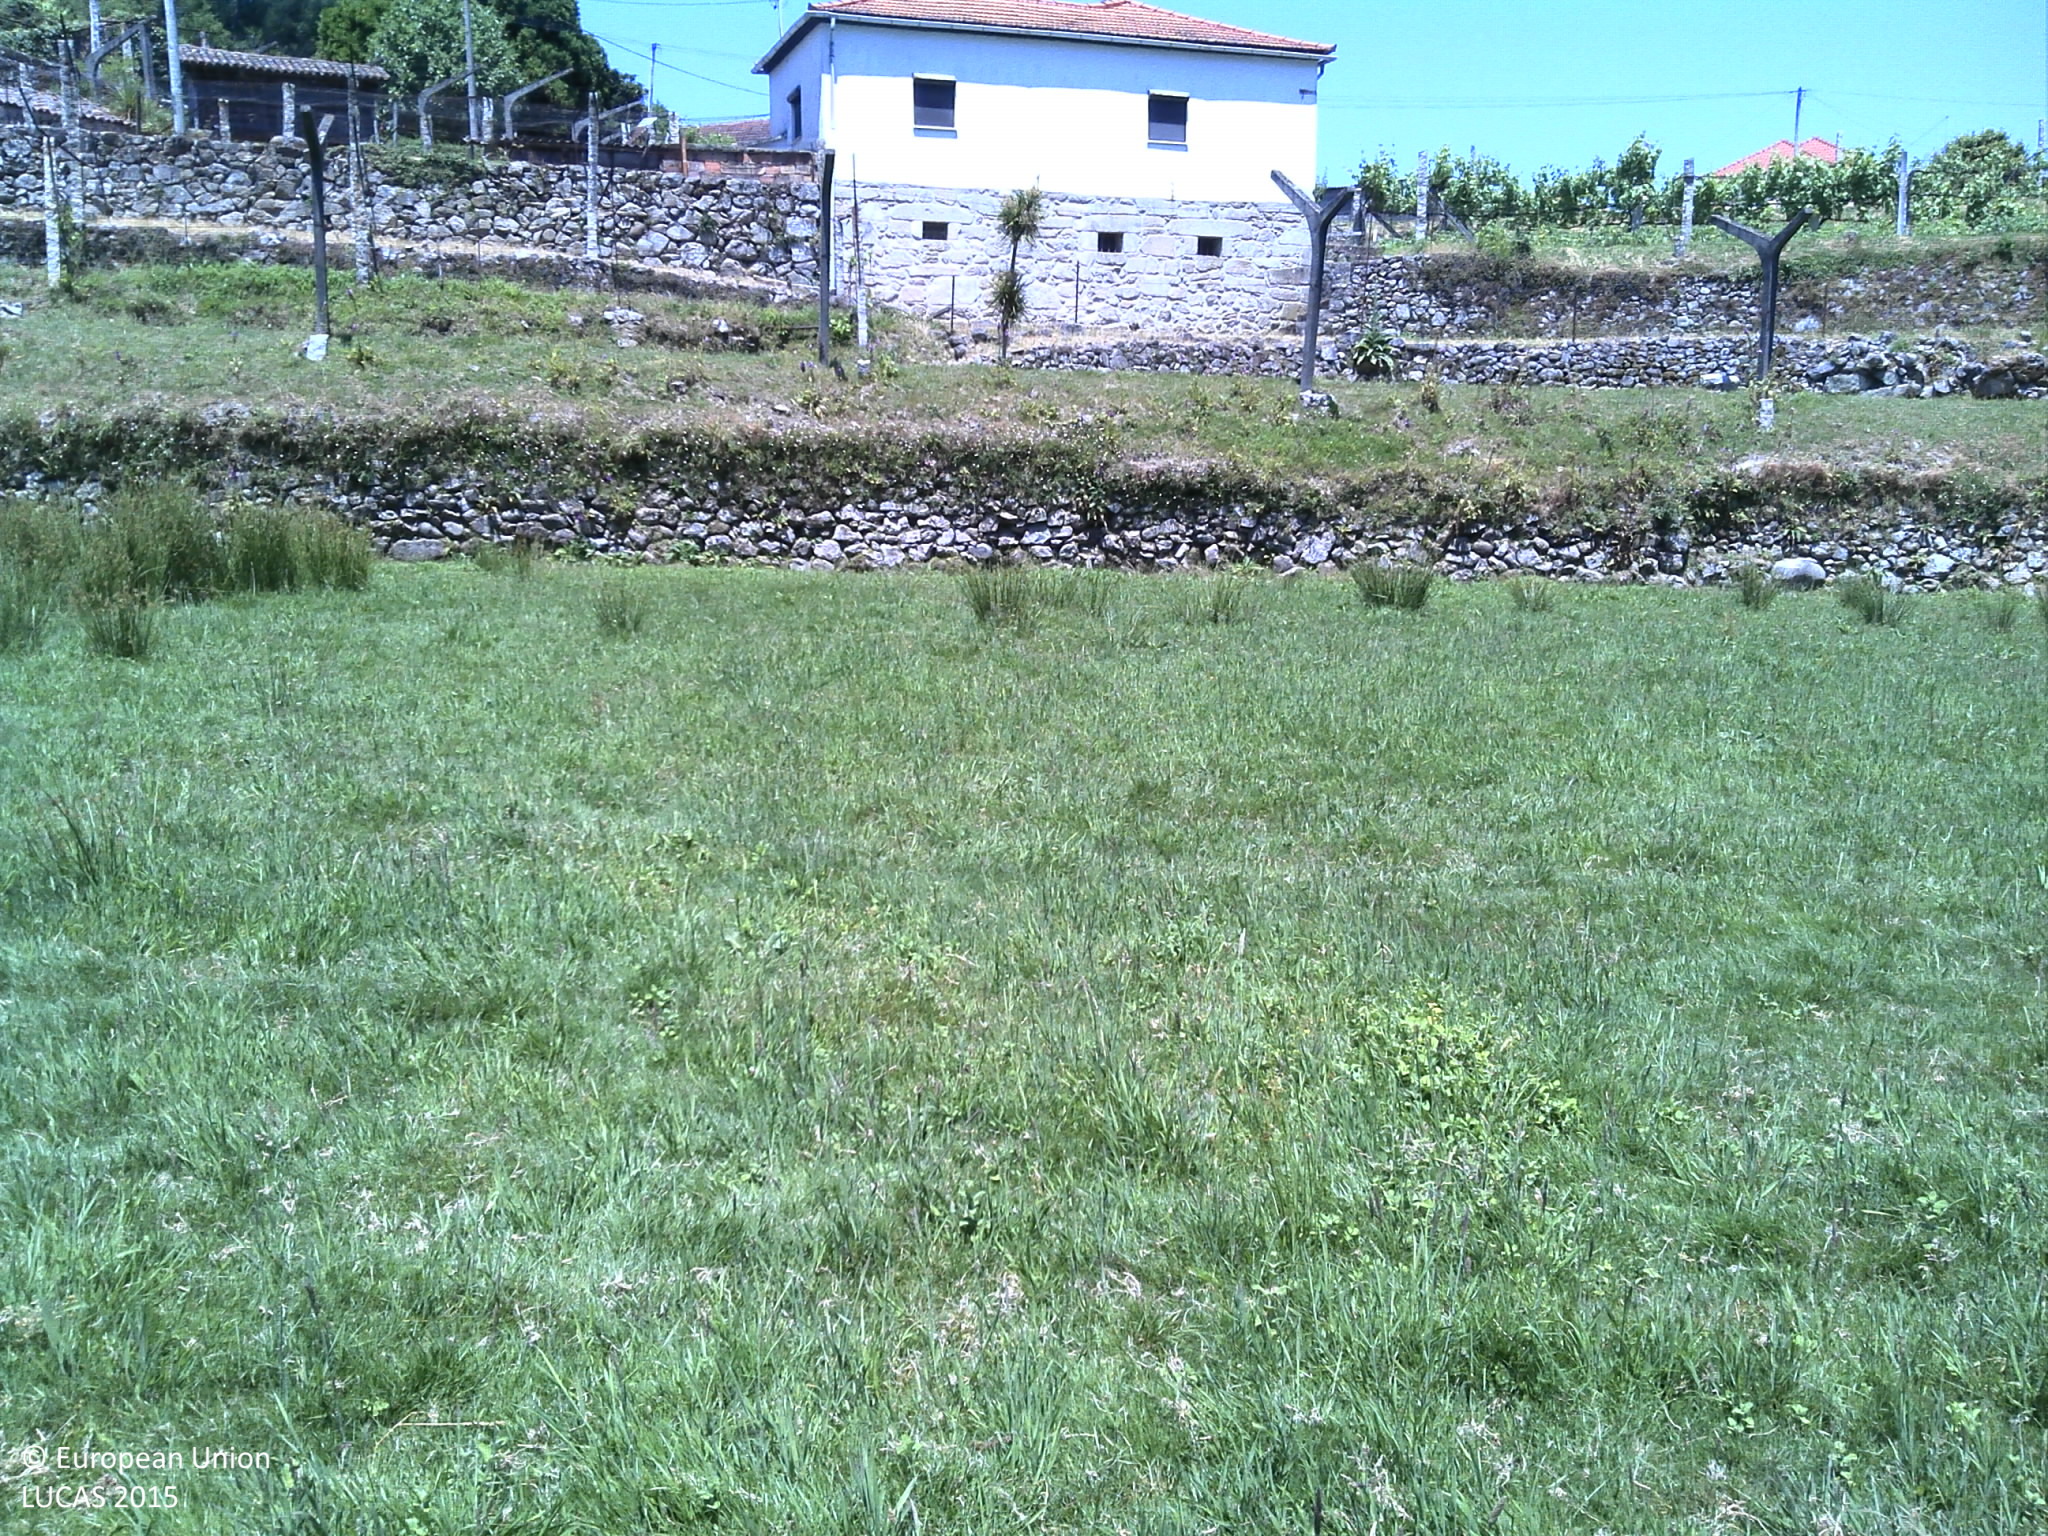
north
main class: Cropland
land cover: Temporary grasslands
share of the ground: > 75 %
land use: Agriculture (excluding fallow land and kitchen gardens)
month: June
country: PT
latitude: 41.9205
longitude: -8.4523
